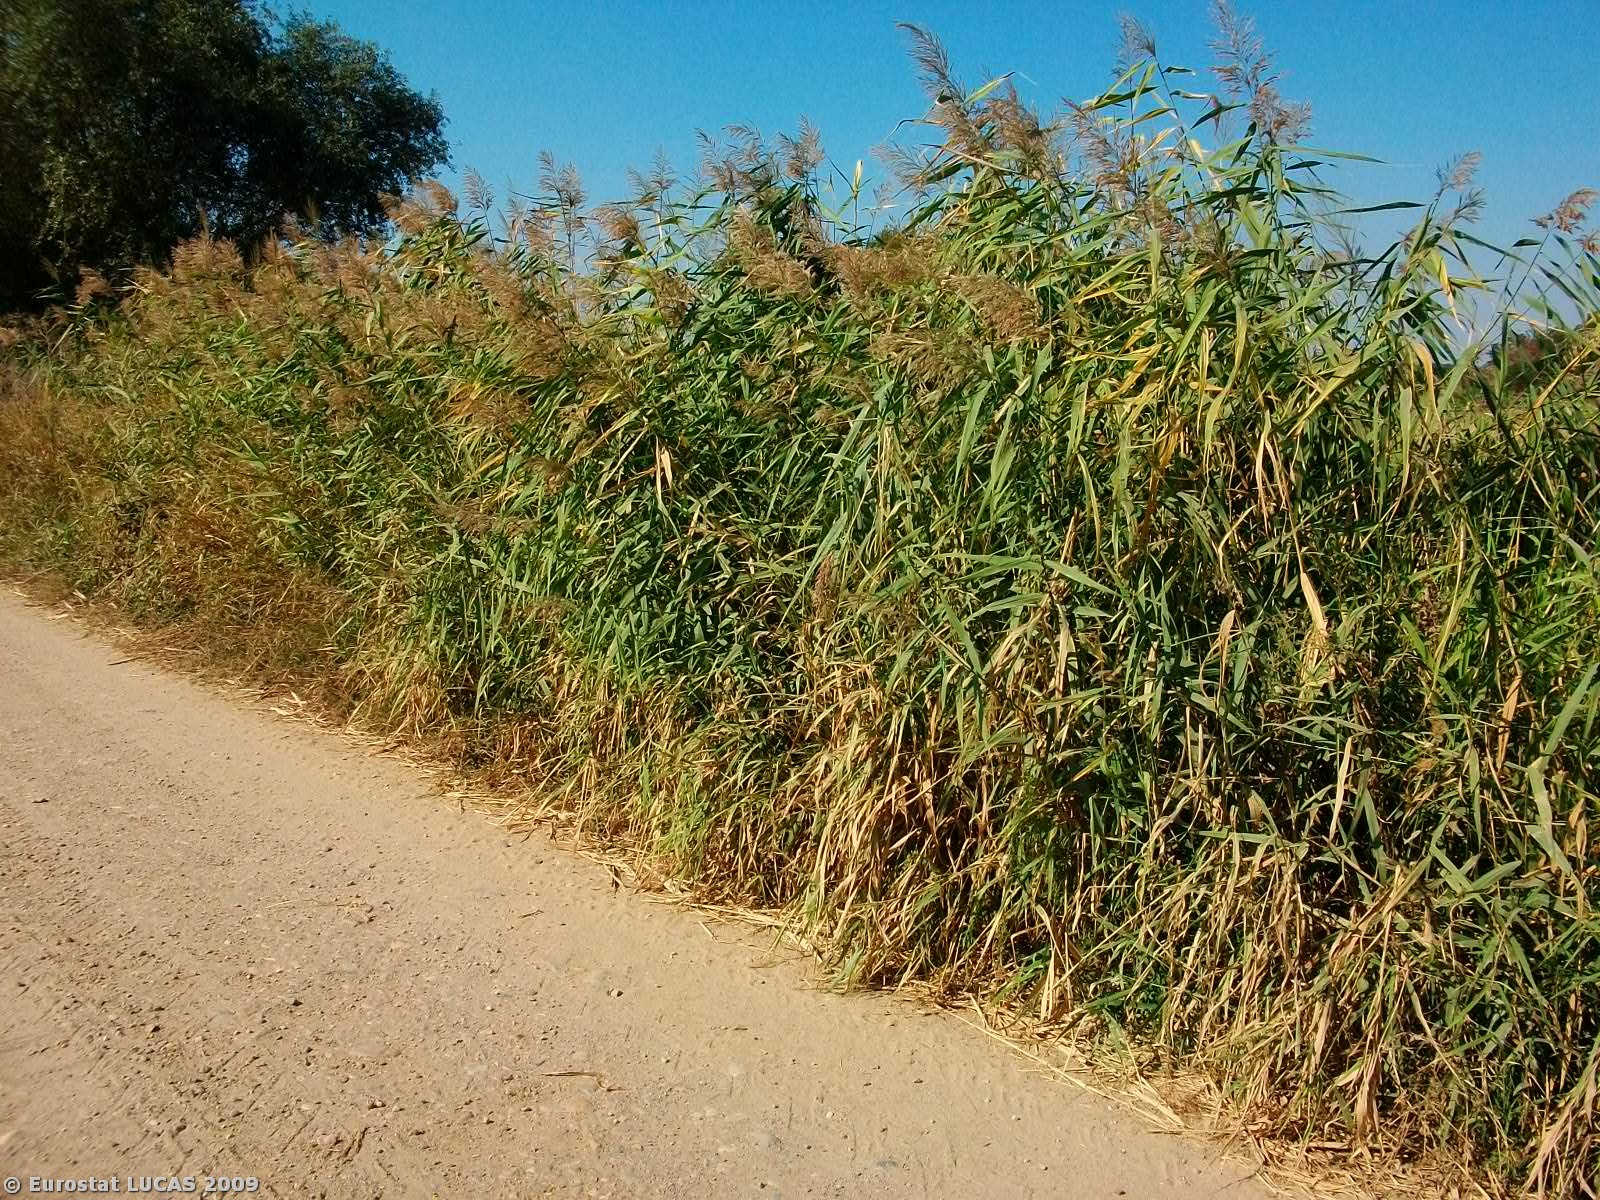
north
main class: Cropland
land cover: Maize
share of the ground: > 75 %
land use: Agriculture (excluding fallow land and kitchen gardens)
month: September
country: GR
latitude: 41.5898
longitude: 26.5764
